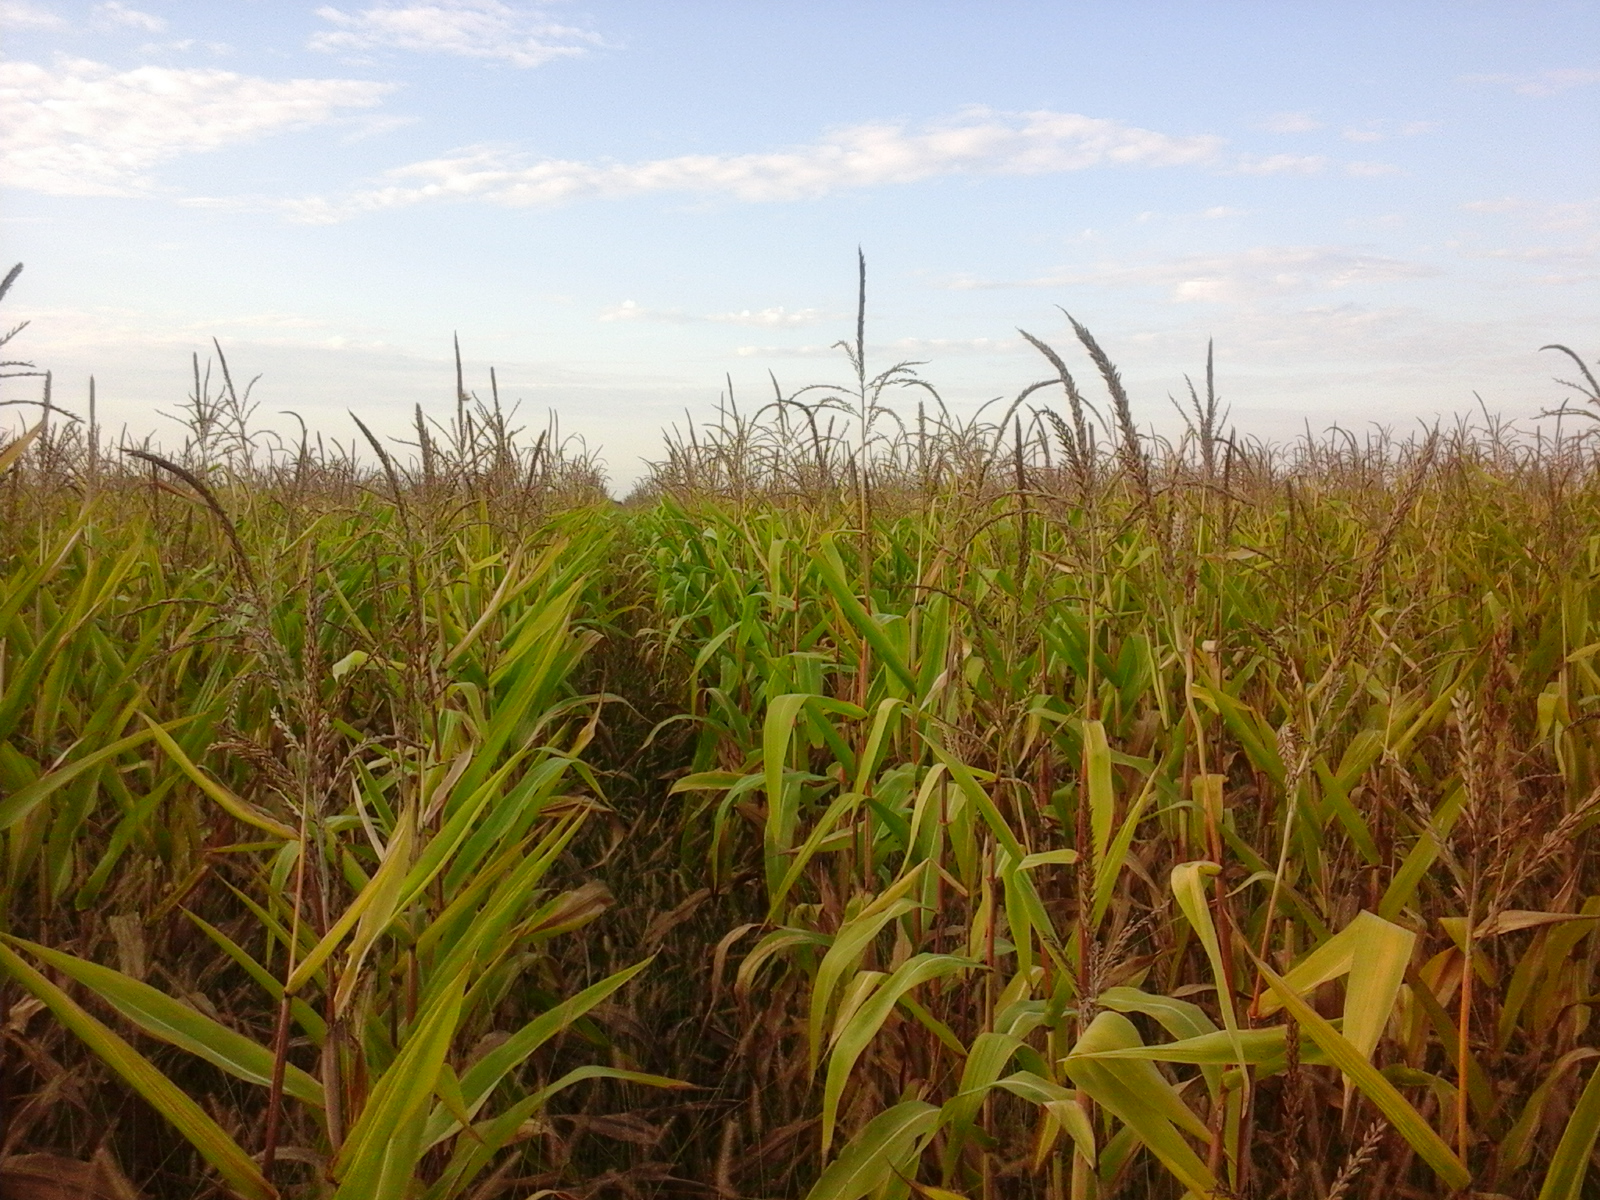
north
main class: Cropland
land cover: Maize
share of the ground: > 75 %
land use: Agriculture (excluding fallow land and kitchen gardens)
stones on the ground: < 10 %
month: August
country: RO
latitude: 46.4505
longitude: 21.7179
